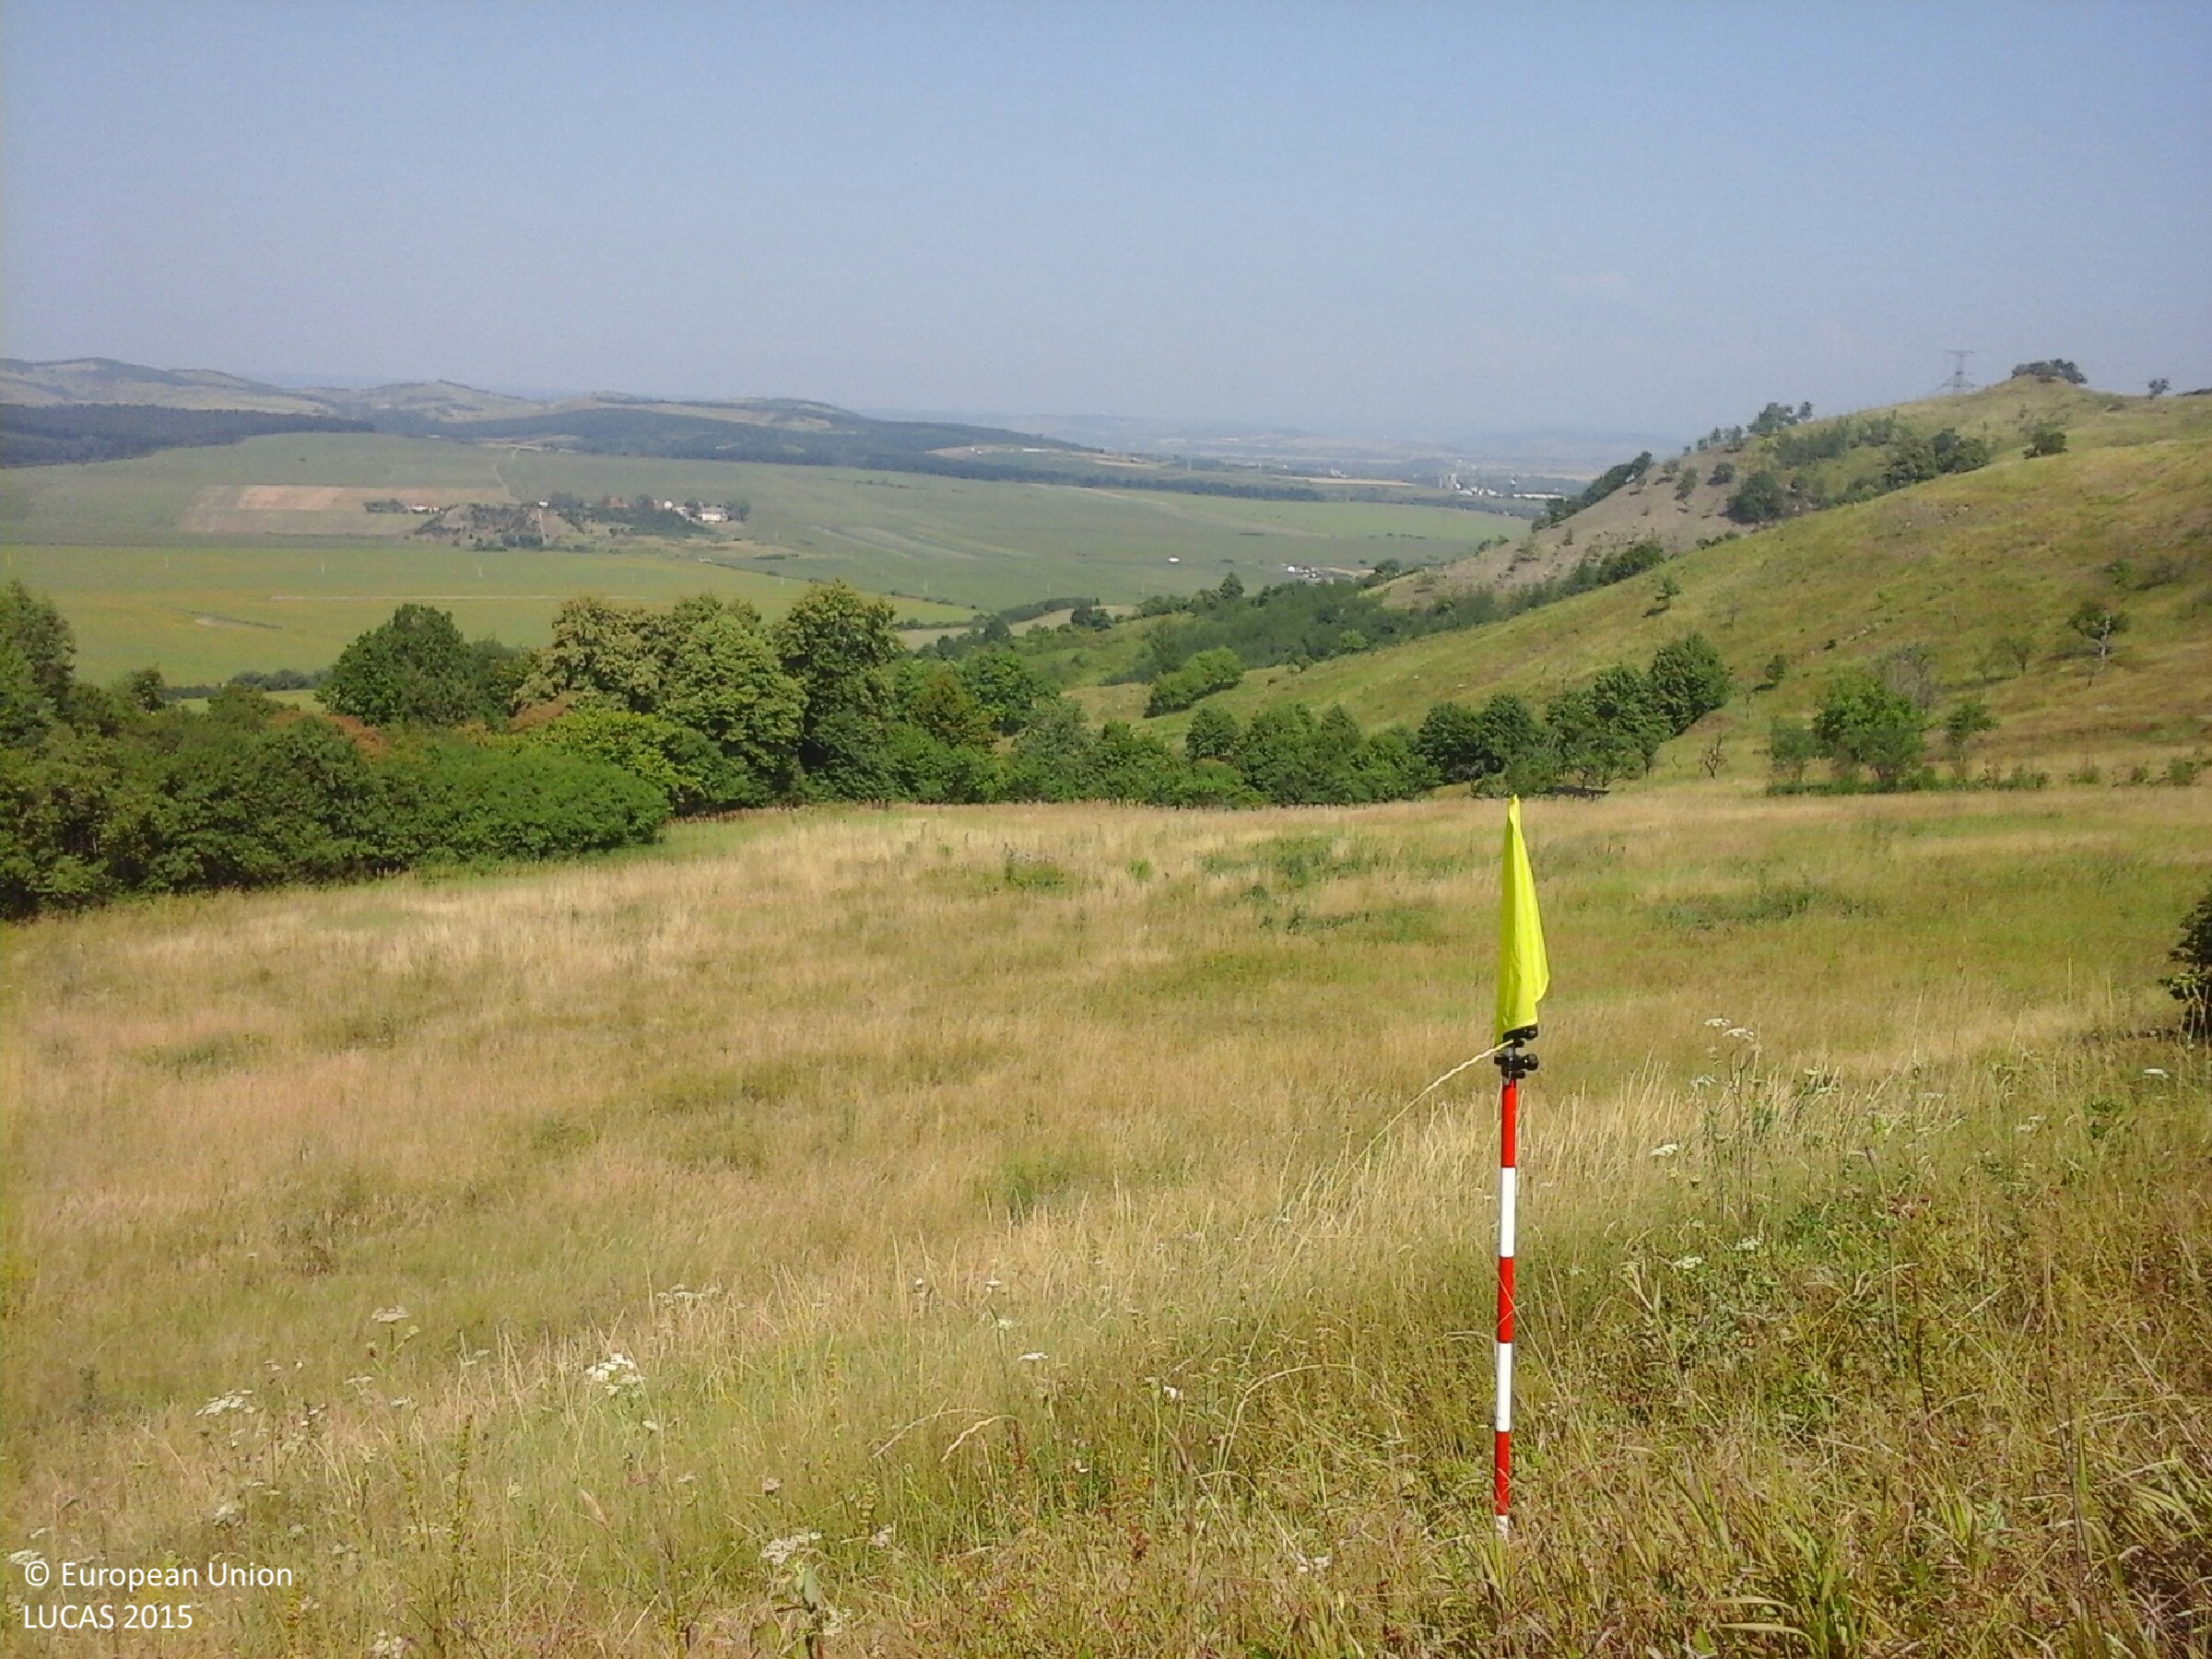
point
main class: Grassland
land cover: Grassland with sparse tree/shrub cover
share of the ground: > 75 %
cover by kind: herbaceous plants 95 %, broadleaved forest trees 5 %
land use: Abandoned areas
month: July
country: HU
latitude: 48.1909
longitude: 20.7037
